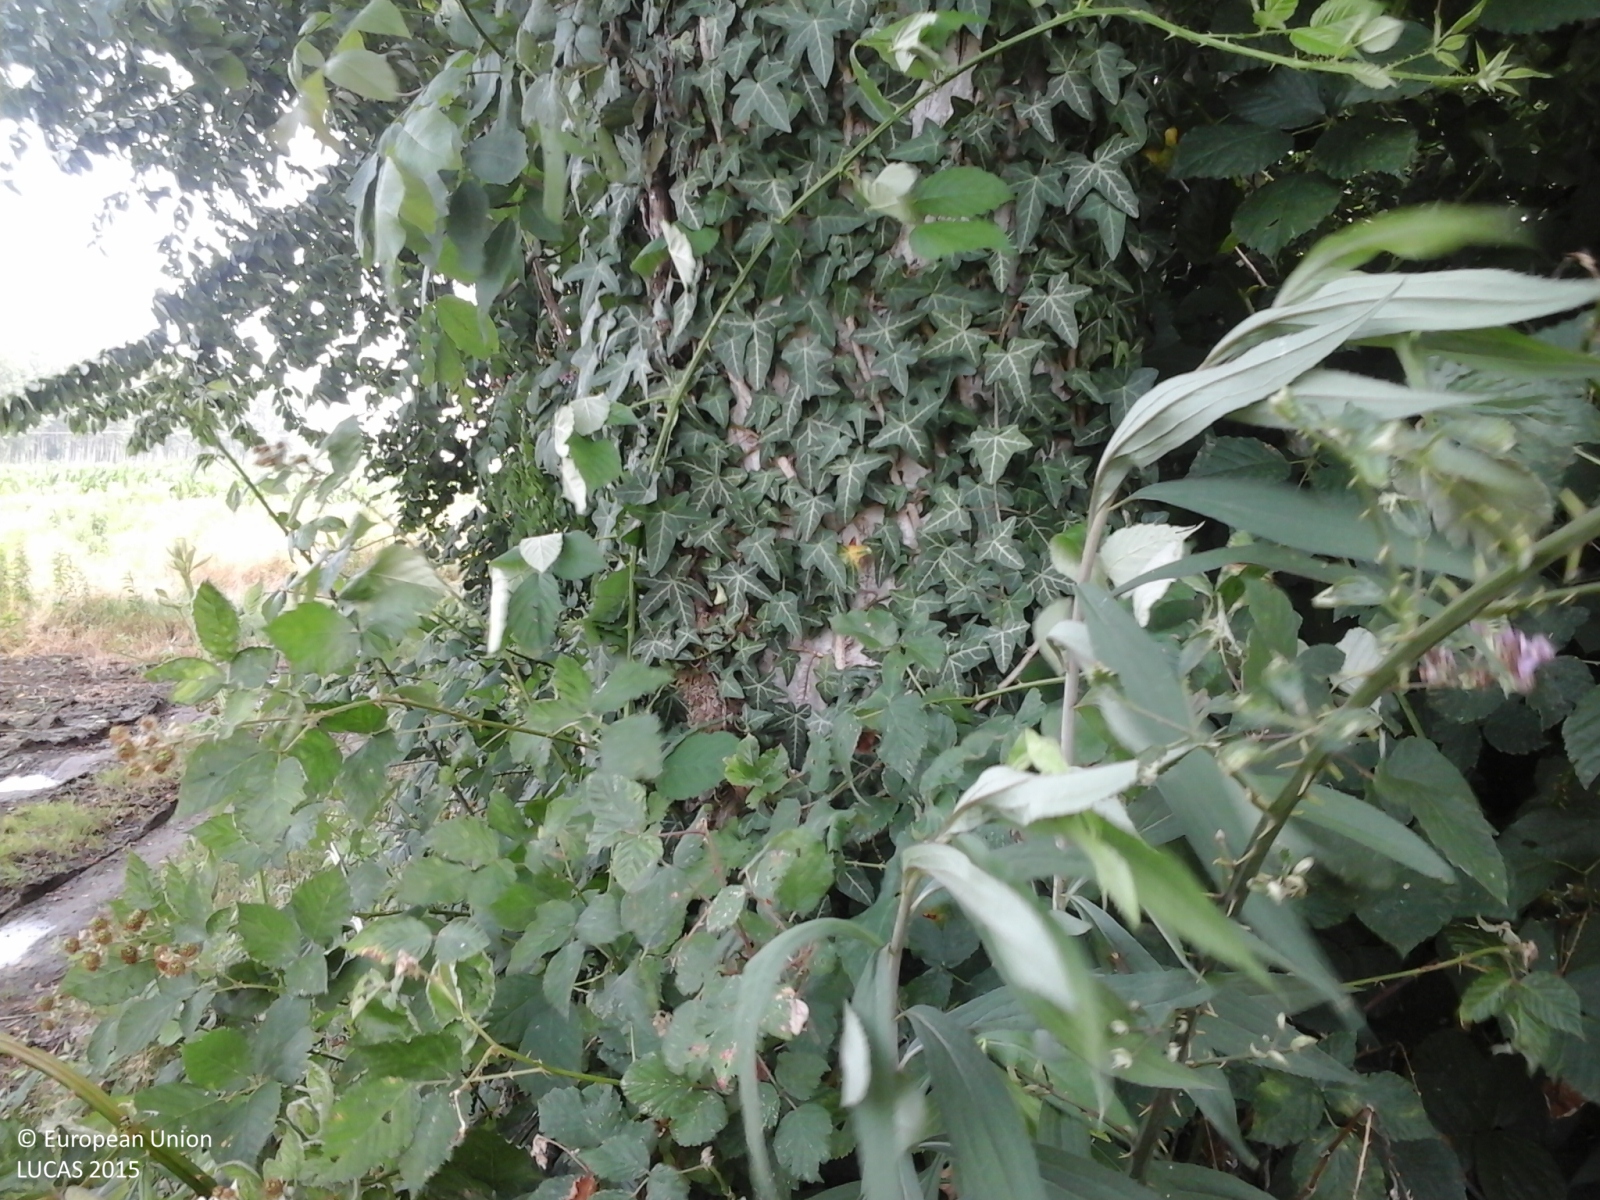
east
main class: Woodland
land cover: Broadleaved woodland
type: thermophilous deciduous forest
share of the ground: > 75 %
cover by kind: broadleaved forest trees 100 %
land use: Forestry
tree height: > 5 m
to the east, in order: Broadleaved woodland; Tracks; Grass margins; Maize; Grass margins; Ditches and canals; Grass margins; Maize; Grass margins; Ditches and canals; Grass margins; Maize; Electric lines; Ditches and canals; Grass margins; Paved roads, cycling and walking lanes; Grass margins; Maize
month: June
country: IT
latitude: 45.4927
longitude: 8.4287
